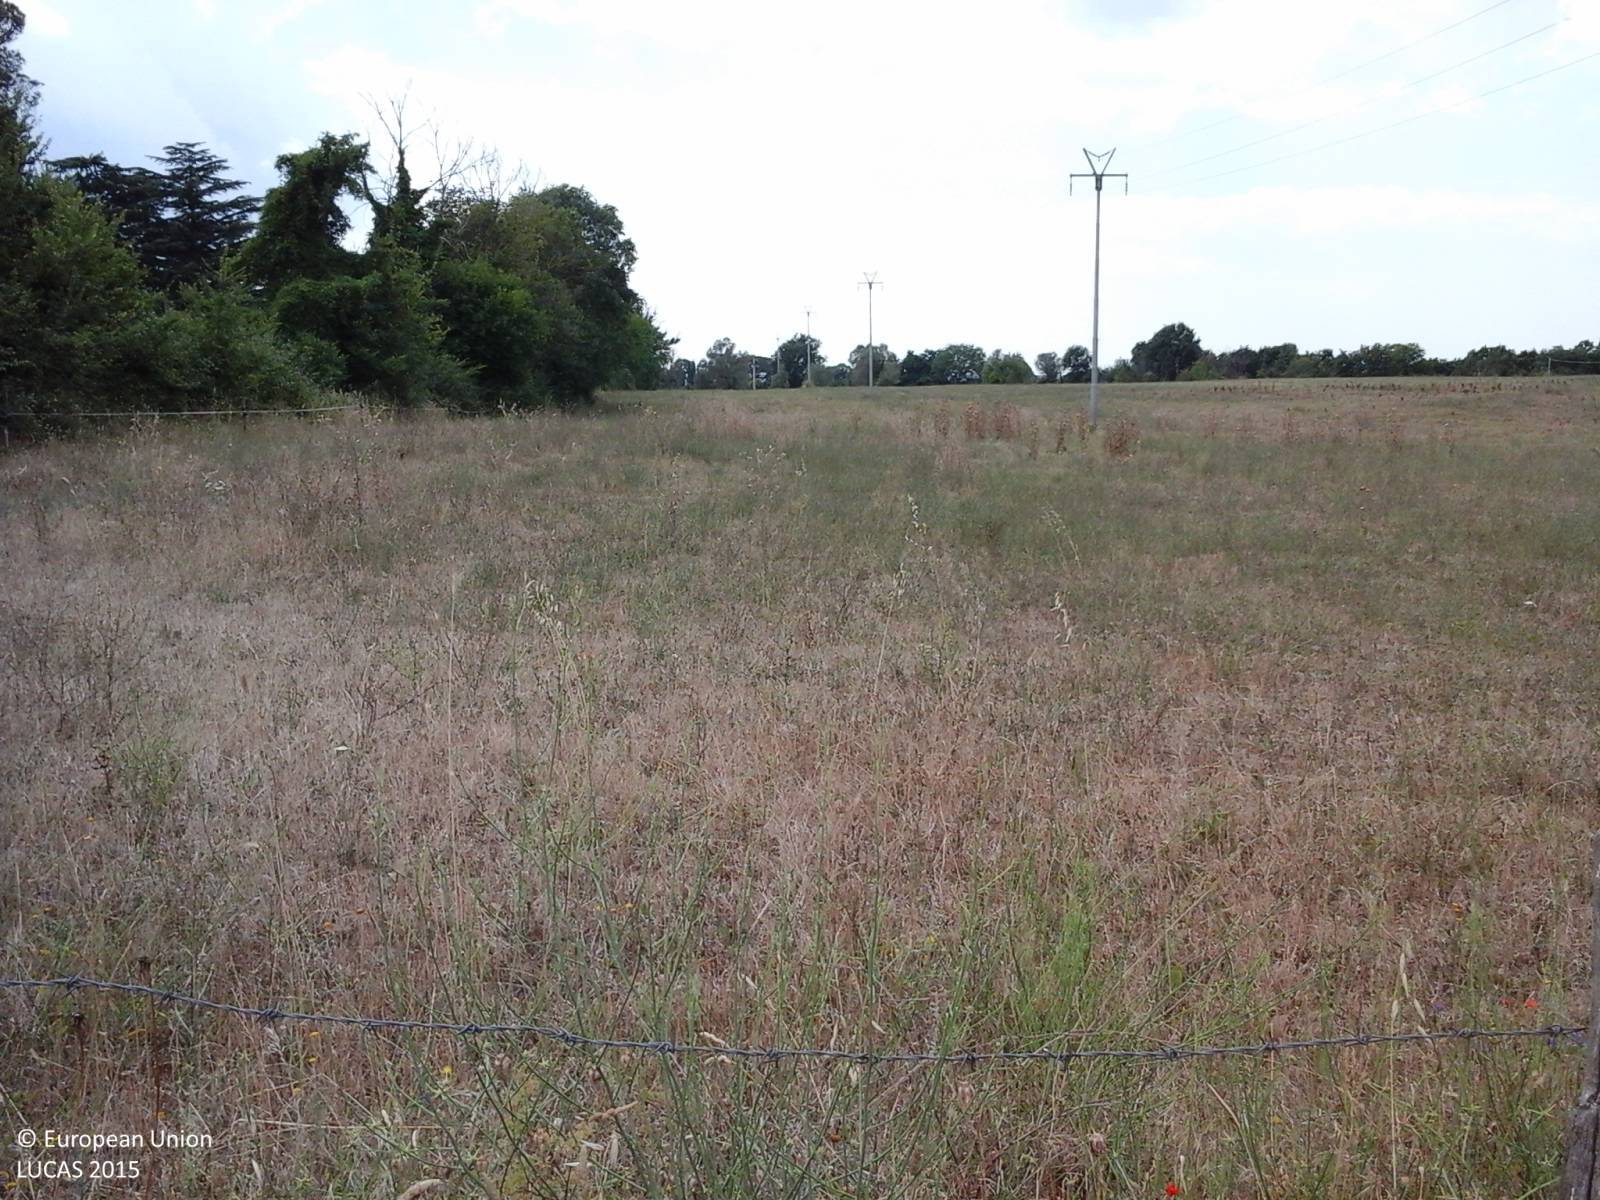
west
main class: Cropland
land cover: Temporary grasslands
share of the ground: > 75 %
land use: Agriculture (excluding fallow land and kitchen gardens)
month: June
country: IT
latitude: 42.2313
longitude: 12.2579
